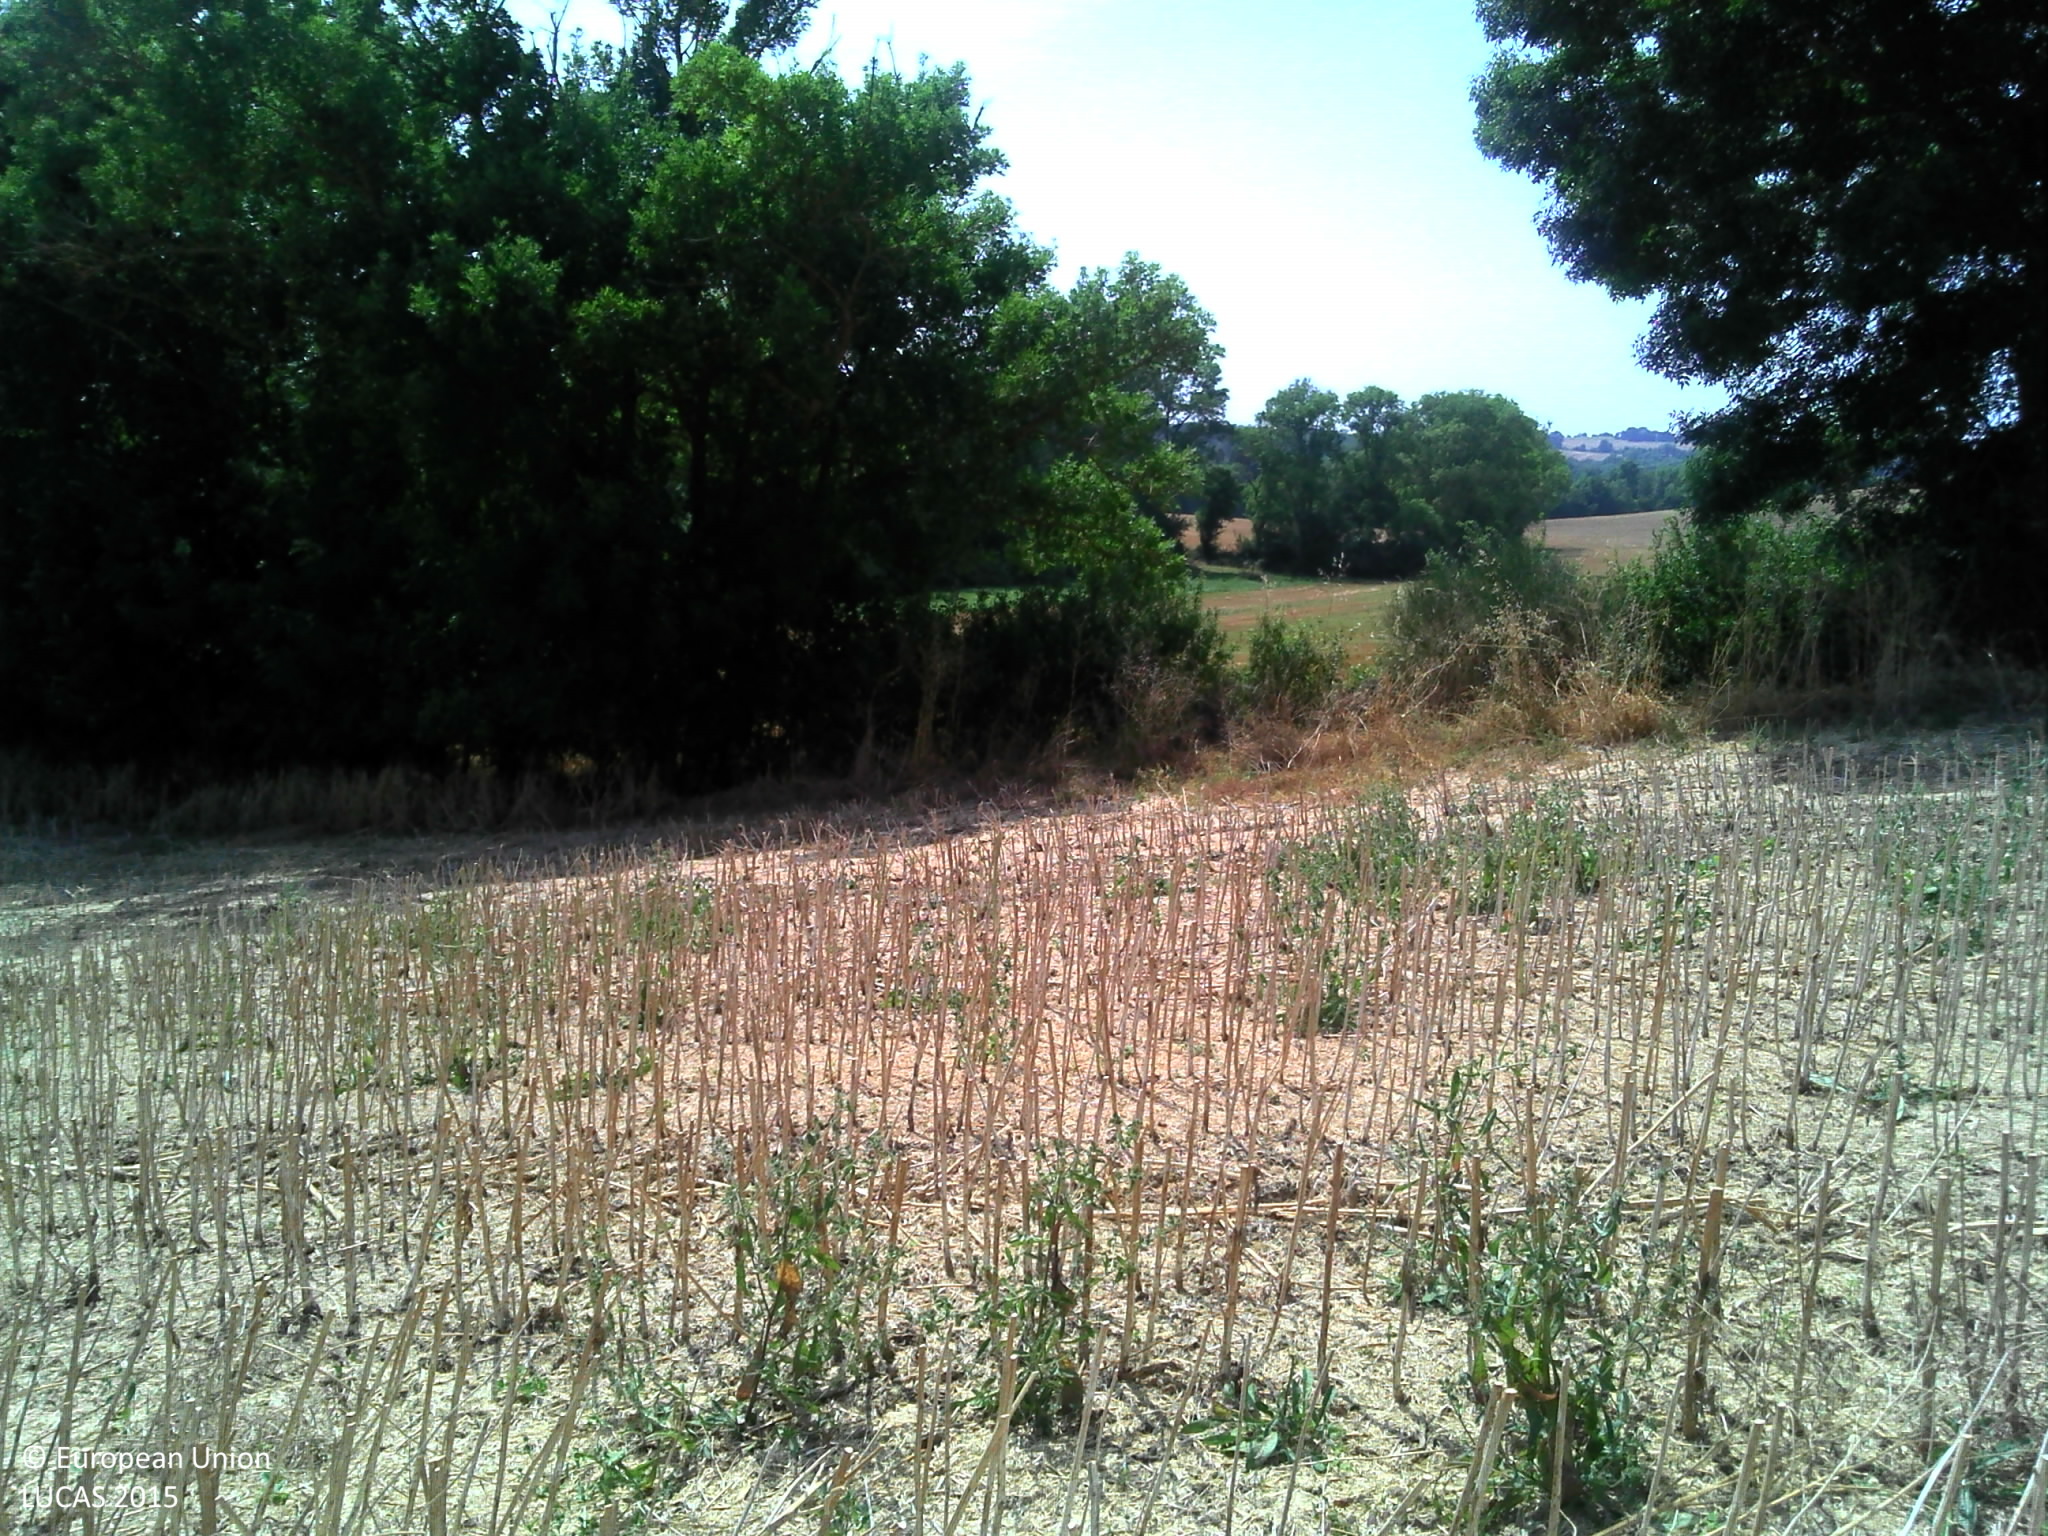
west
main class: Cropland
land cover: Rape and turnip rape
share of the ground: 10 - 25 %
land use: Agriculture (excluding fallow land and kitchen gardens)
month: July
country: FR
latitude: 43.6449
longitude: 0.9374
